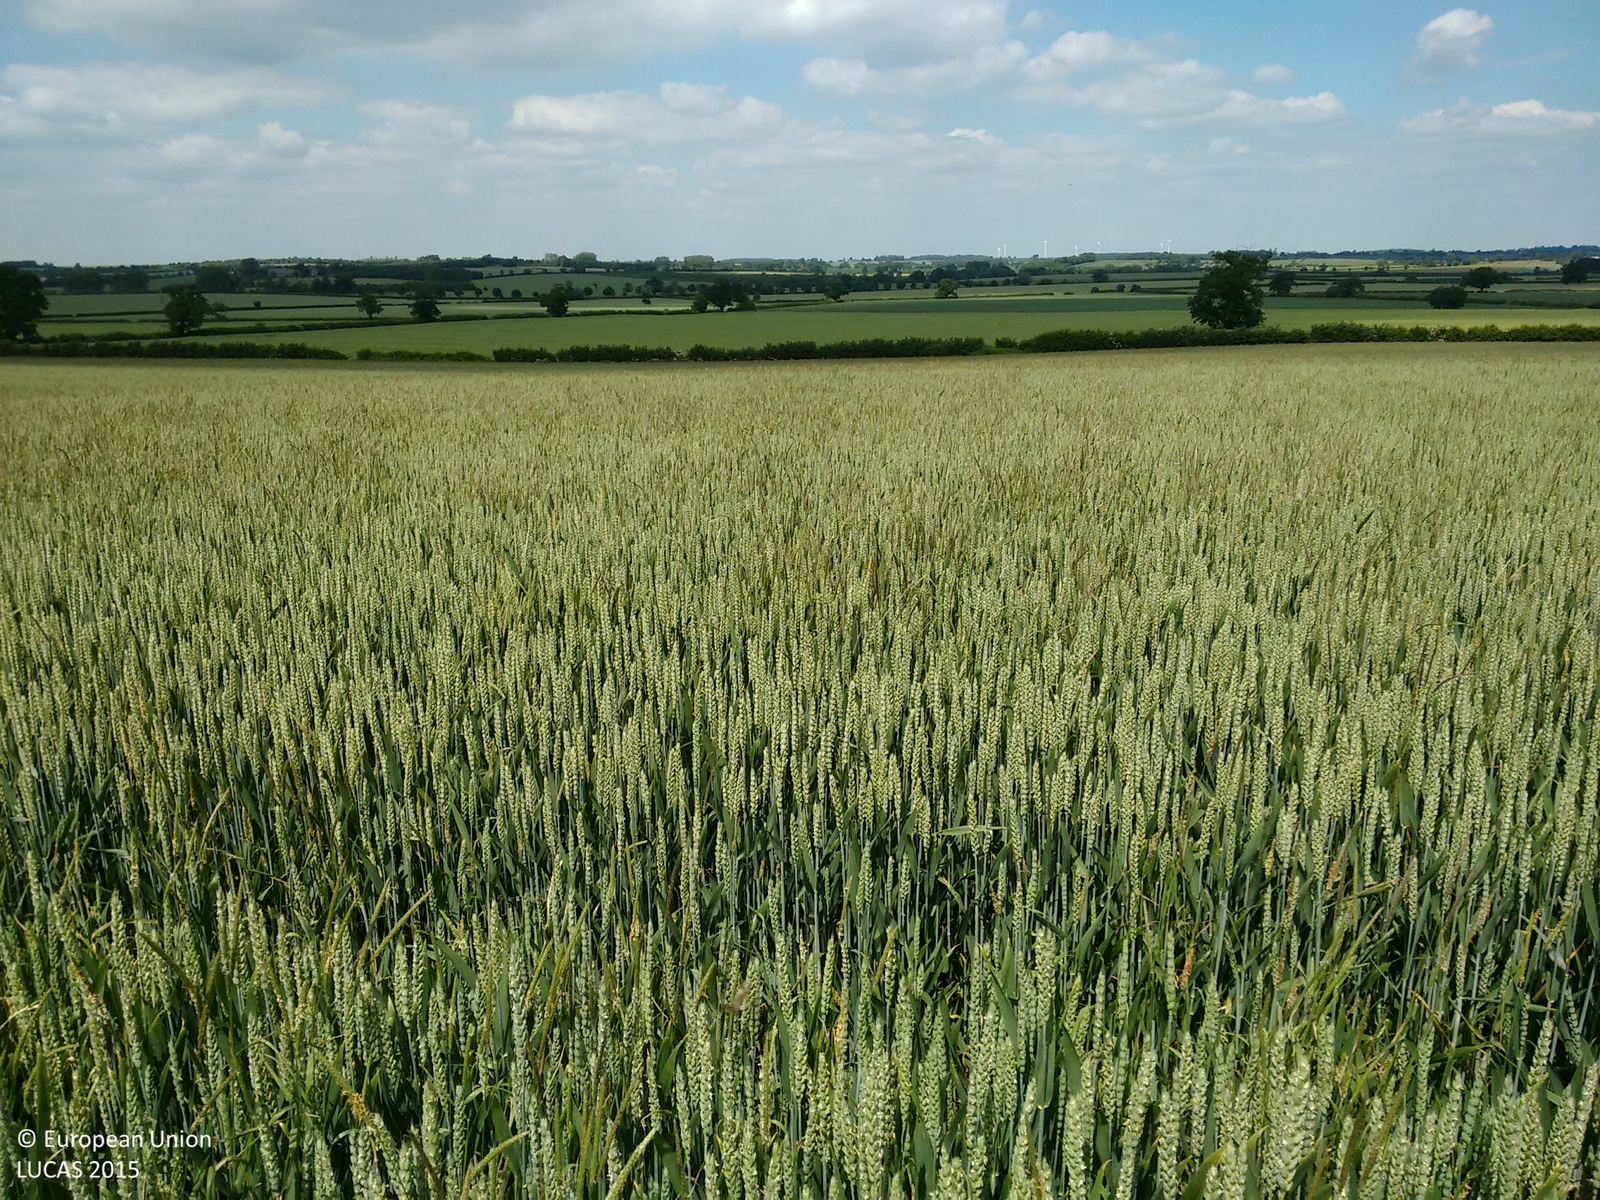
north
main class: Cropland
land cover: Common wheat
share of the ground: > 75 %
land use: Agriculture (excluding fallow land and kitchen gardens)
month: June
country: GB
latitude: 52.0759
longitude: -0.6769
